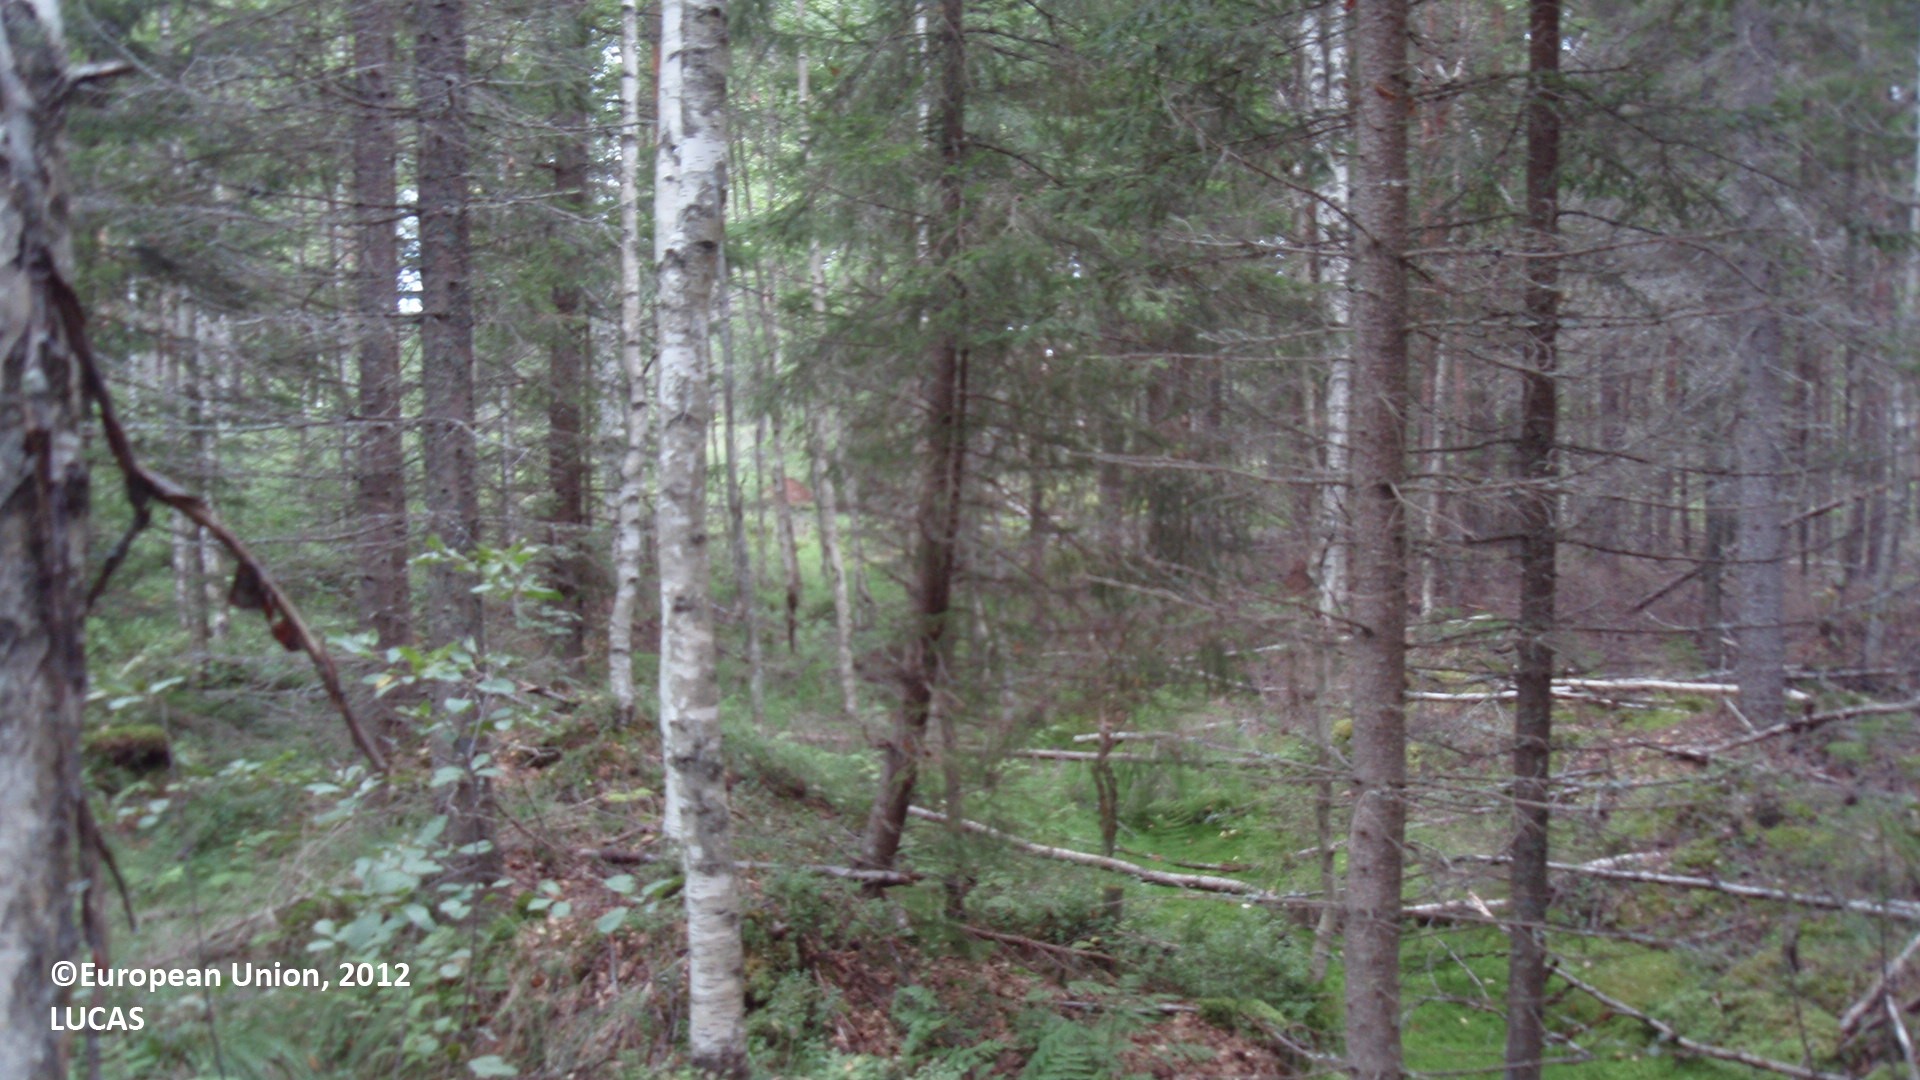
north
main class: Woodland
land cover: Other coniferous woodland
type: boreal forest
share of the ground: > 75 %
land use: Forestry
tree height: > 5 m
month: August
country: FI
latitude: 61.1200
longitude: 27.4217
